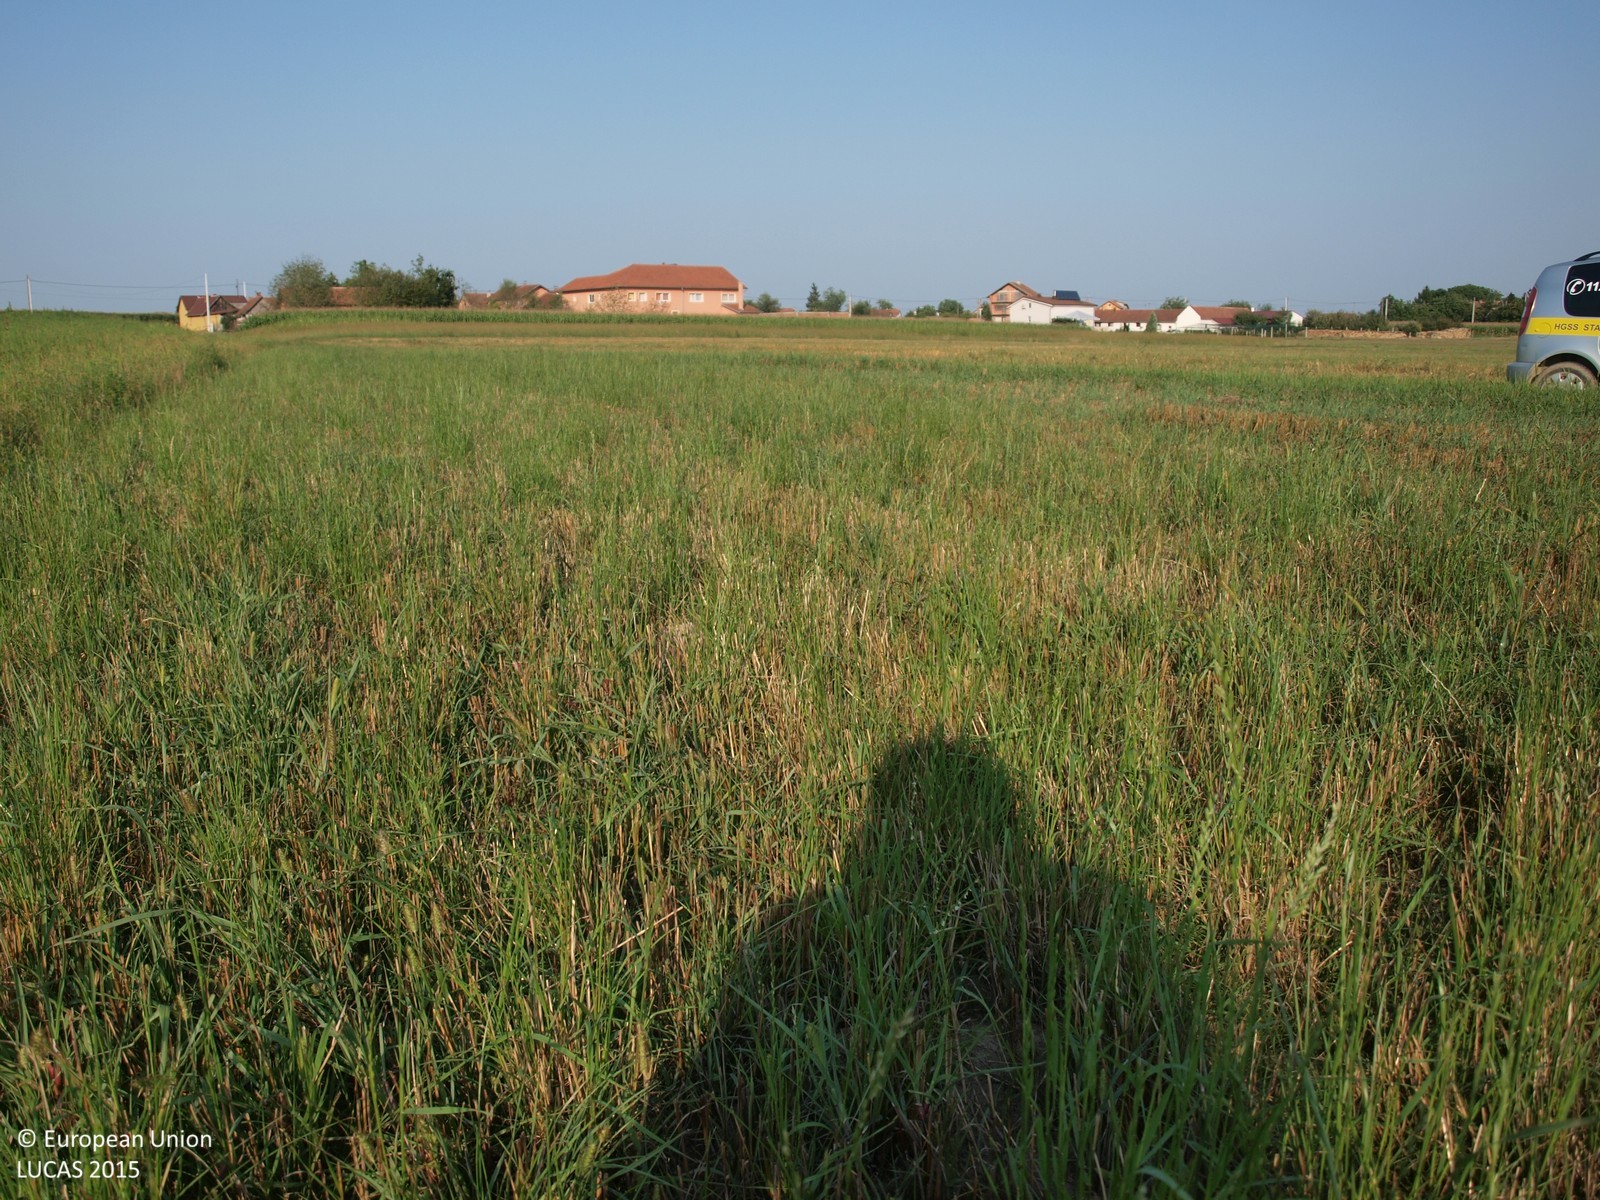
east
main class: Cropland
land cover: Oats
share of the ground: > 75 %
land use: Agriculture (excluding fallow land and kitchen gardens)
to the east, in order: Oats; Tracks; Oats; Grassland without tree/shrub cover; Other fibre and oleaginous crops; Maize; Fences; Grassland without tree/shrub cover; Fences; Grassland without tree/shrub cover
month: August
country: HR
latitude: 45.8250
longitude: 16.5511
